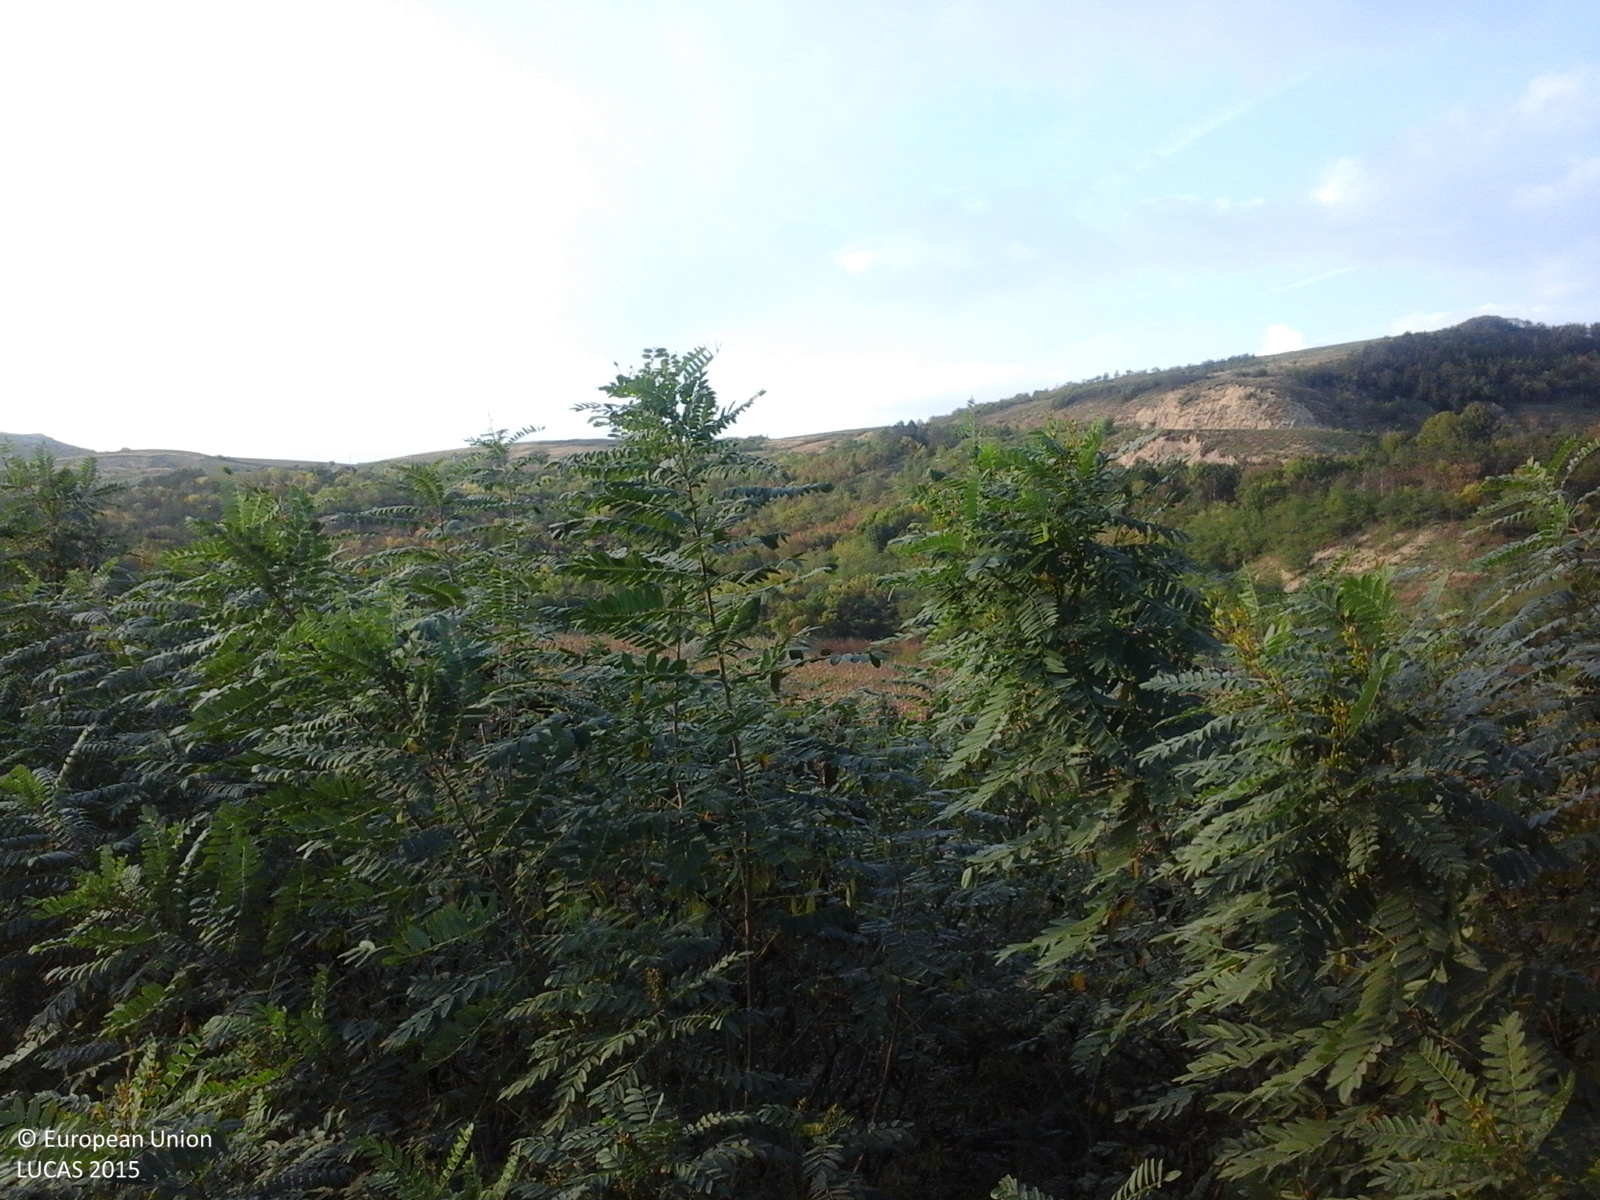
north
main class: Shrubland
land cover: Shrubland with sparse tree cover
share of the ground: > 75 %
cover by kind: shrubs 95 %, broadleaved forest trees 5 %
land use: Road transport
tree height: < 5 m
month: October
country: RO
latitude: 46.4740
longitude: 24.0791
